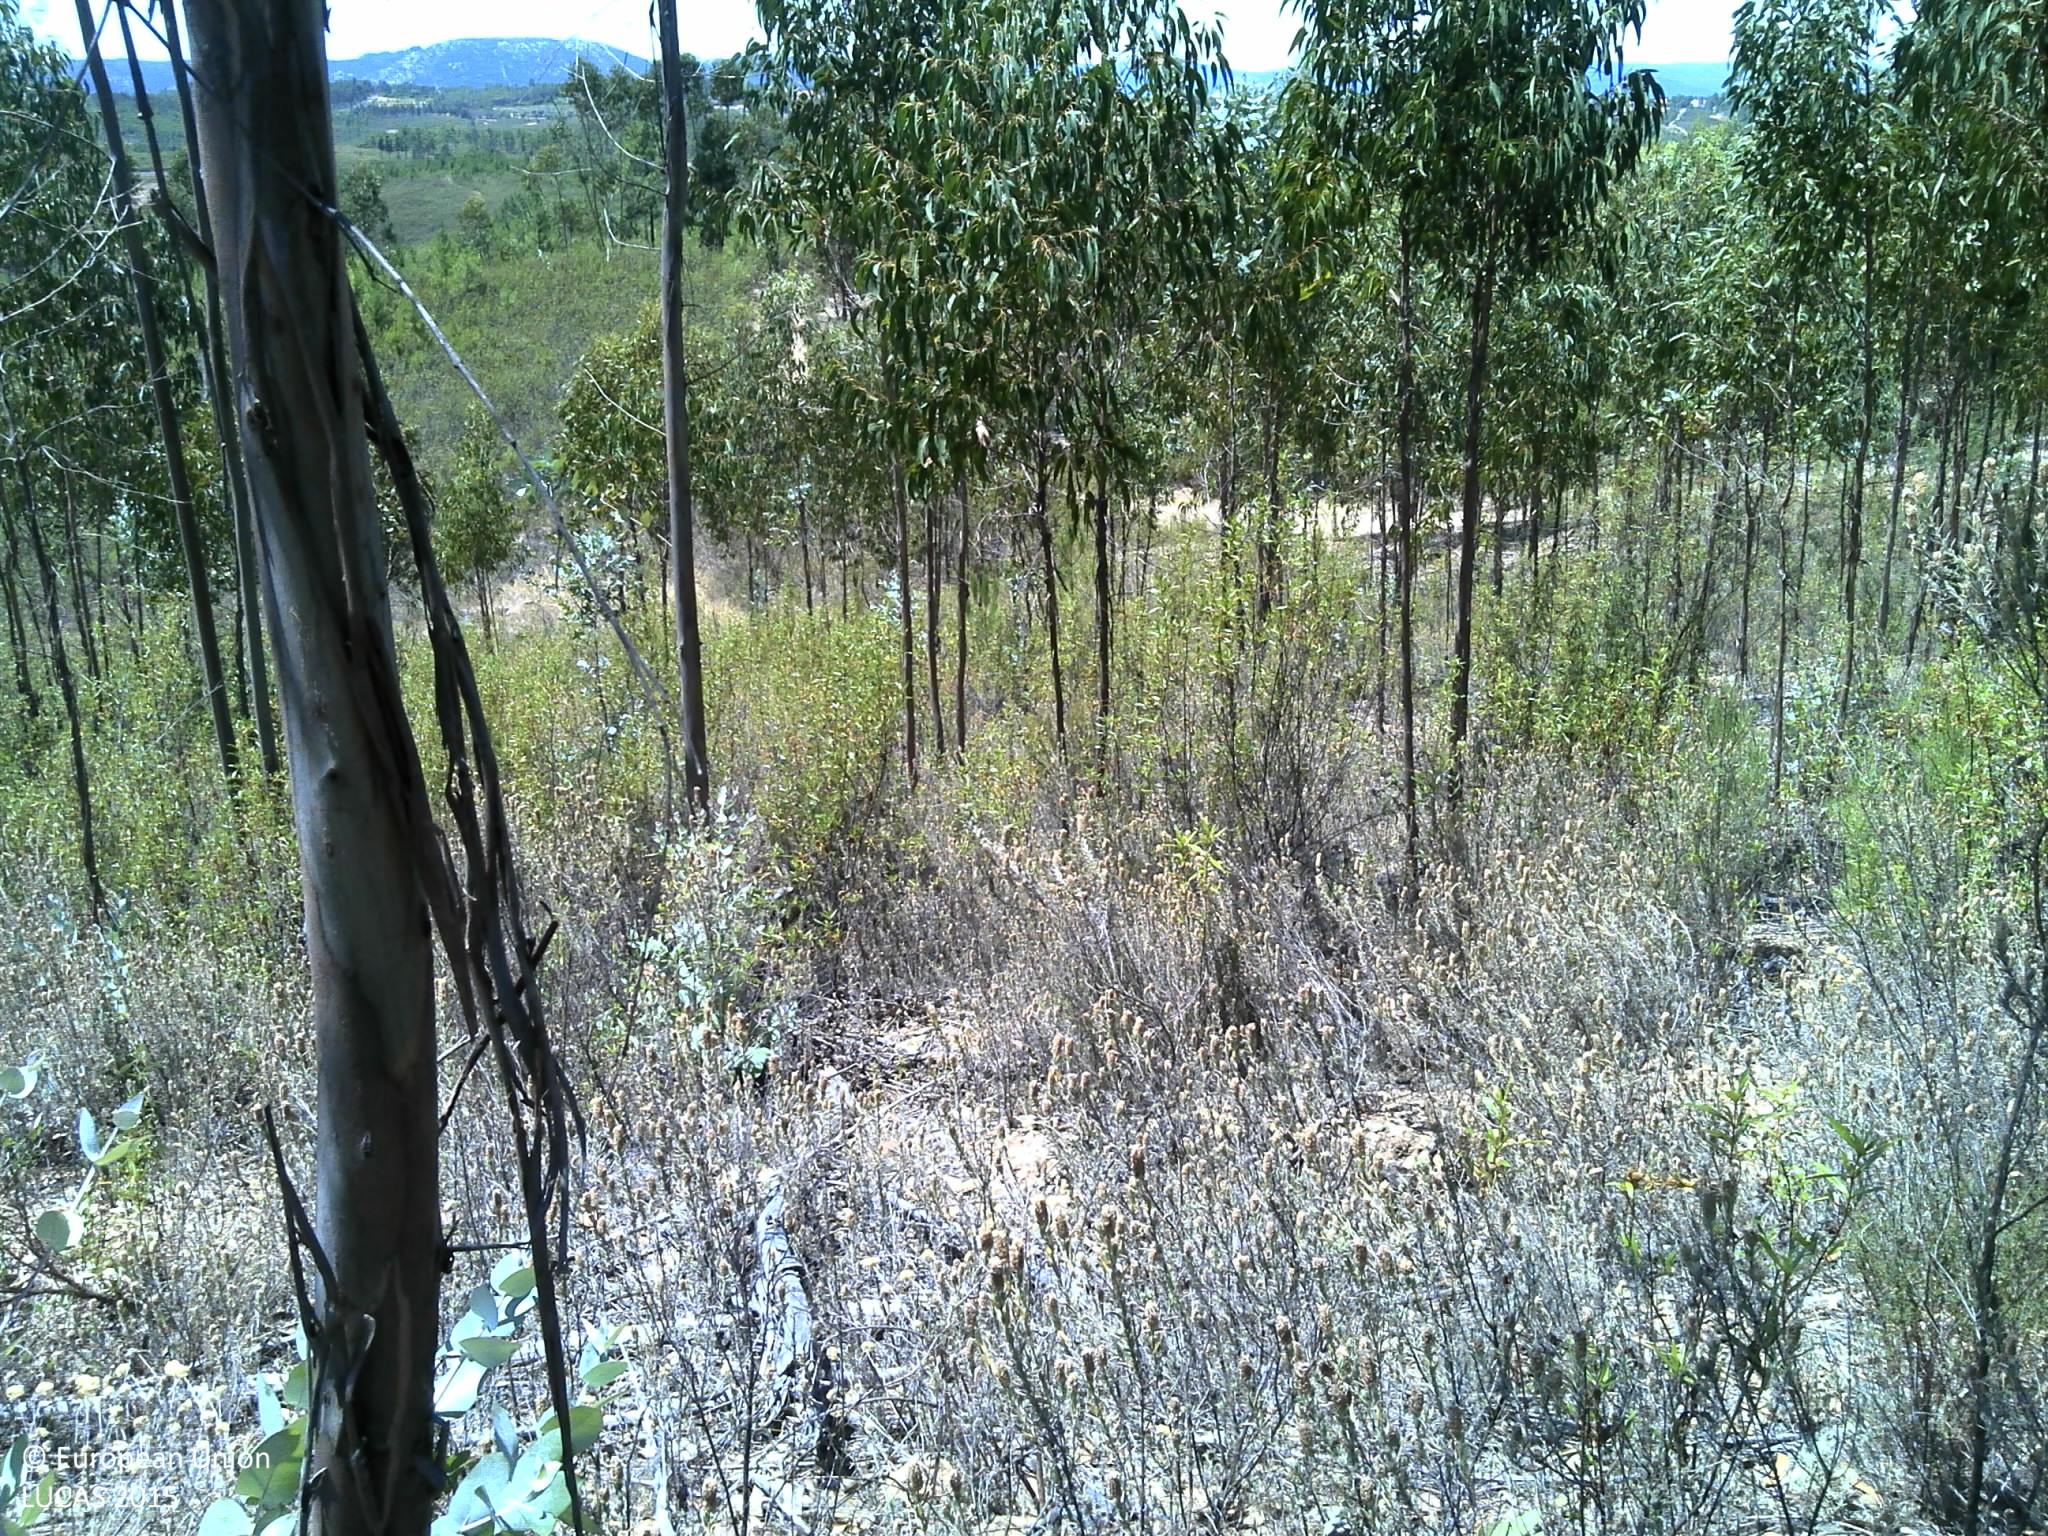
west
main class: Woodland
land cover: Broadleaved woodland
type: exotic forest
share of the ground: 10 - 25 %
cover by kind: shrubs 30 %, consolidated bare surface 30 %, unconsolidated bare surface 20 %, broadleaved forest trees 15 %, herbaceous plants 5 %
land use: Forestry
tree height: > 5 m
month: July
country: PT
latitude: 39.7707
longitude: -7.6963
